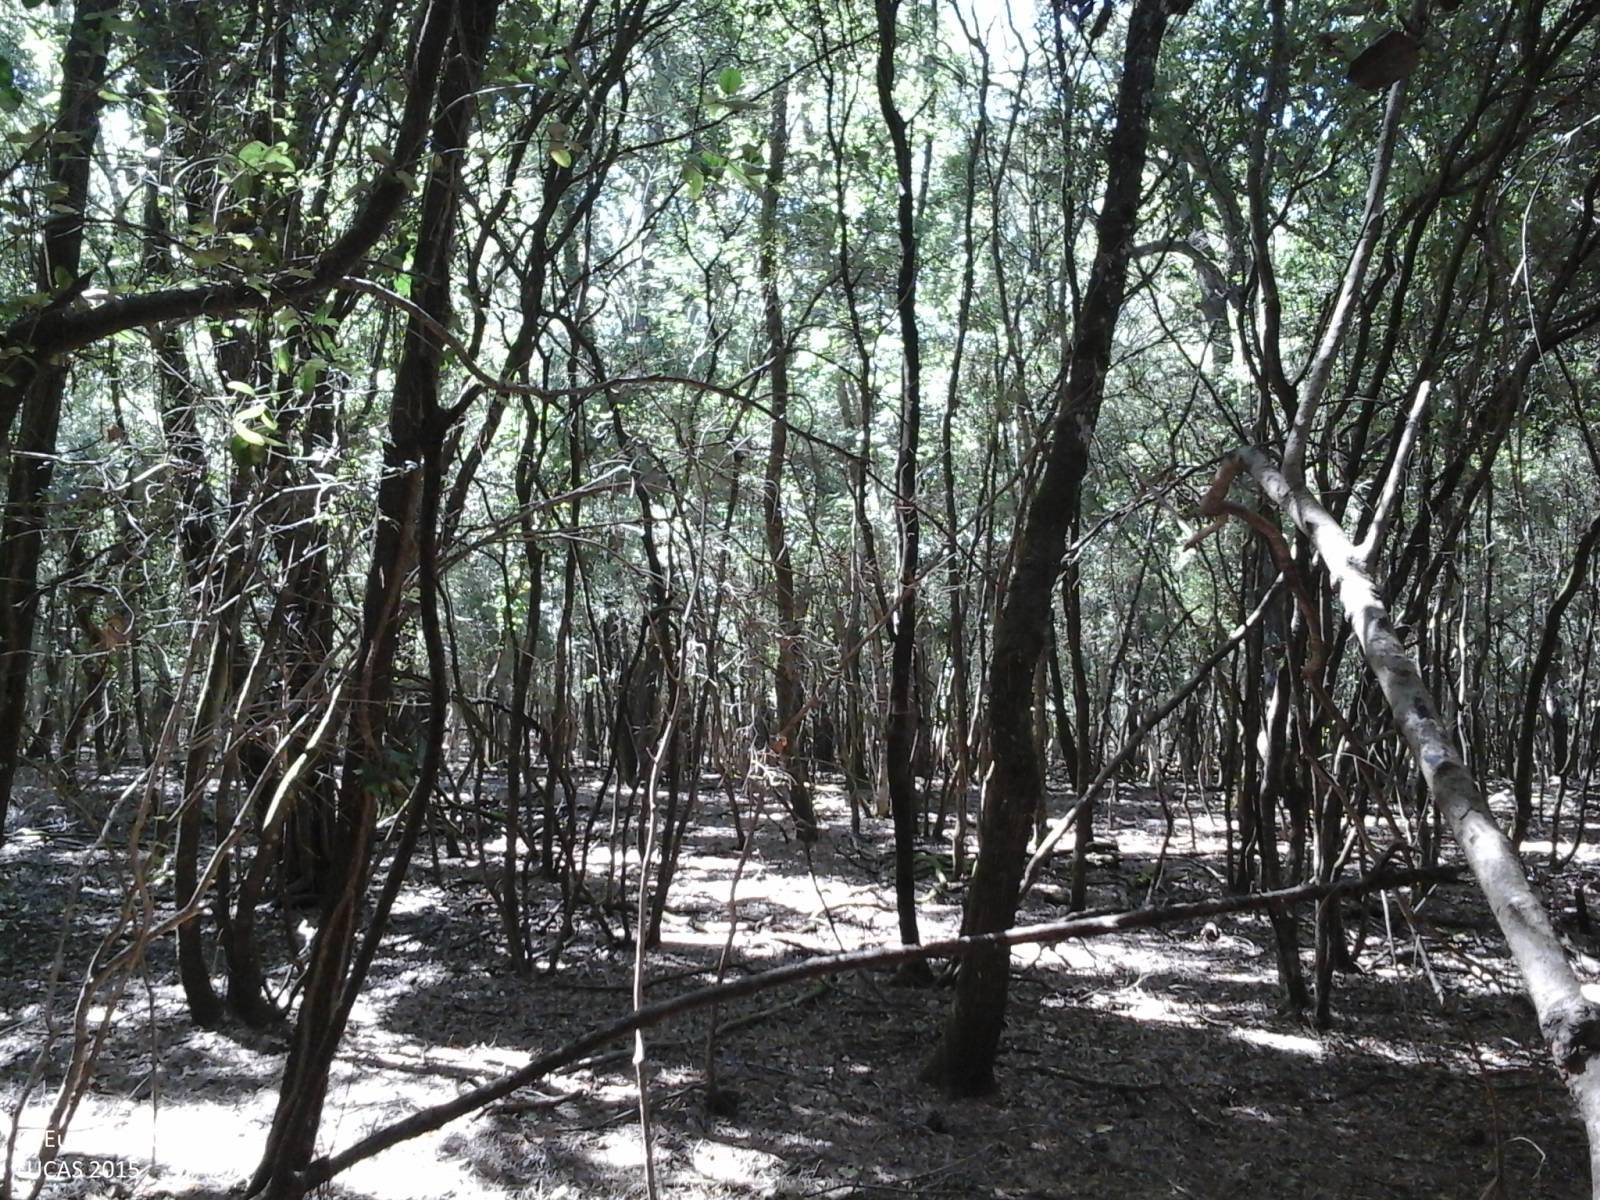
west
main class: Woodland
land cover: Pine dominated mixed woodland
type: coniferous forest of the mediterranean region
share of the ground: > 75 %
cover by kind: coniferous forest trees 75 %, broadleaved forest trees 25 %
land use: Semi-natural and natural areas not in use
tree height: > 5 m
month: August
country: IT
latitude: 41.3059
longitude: 13.0571
